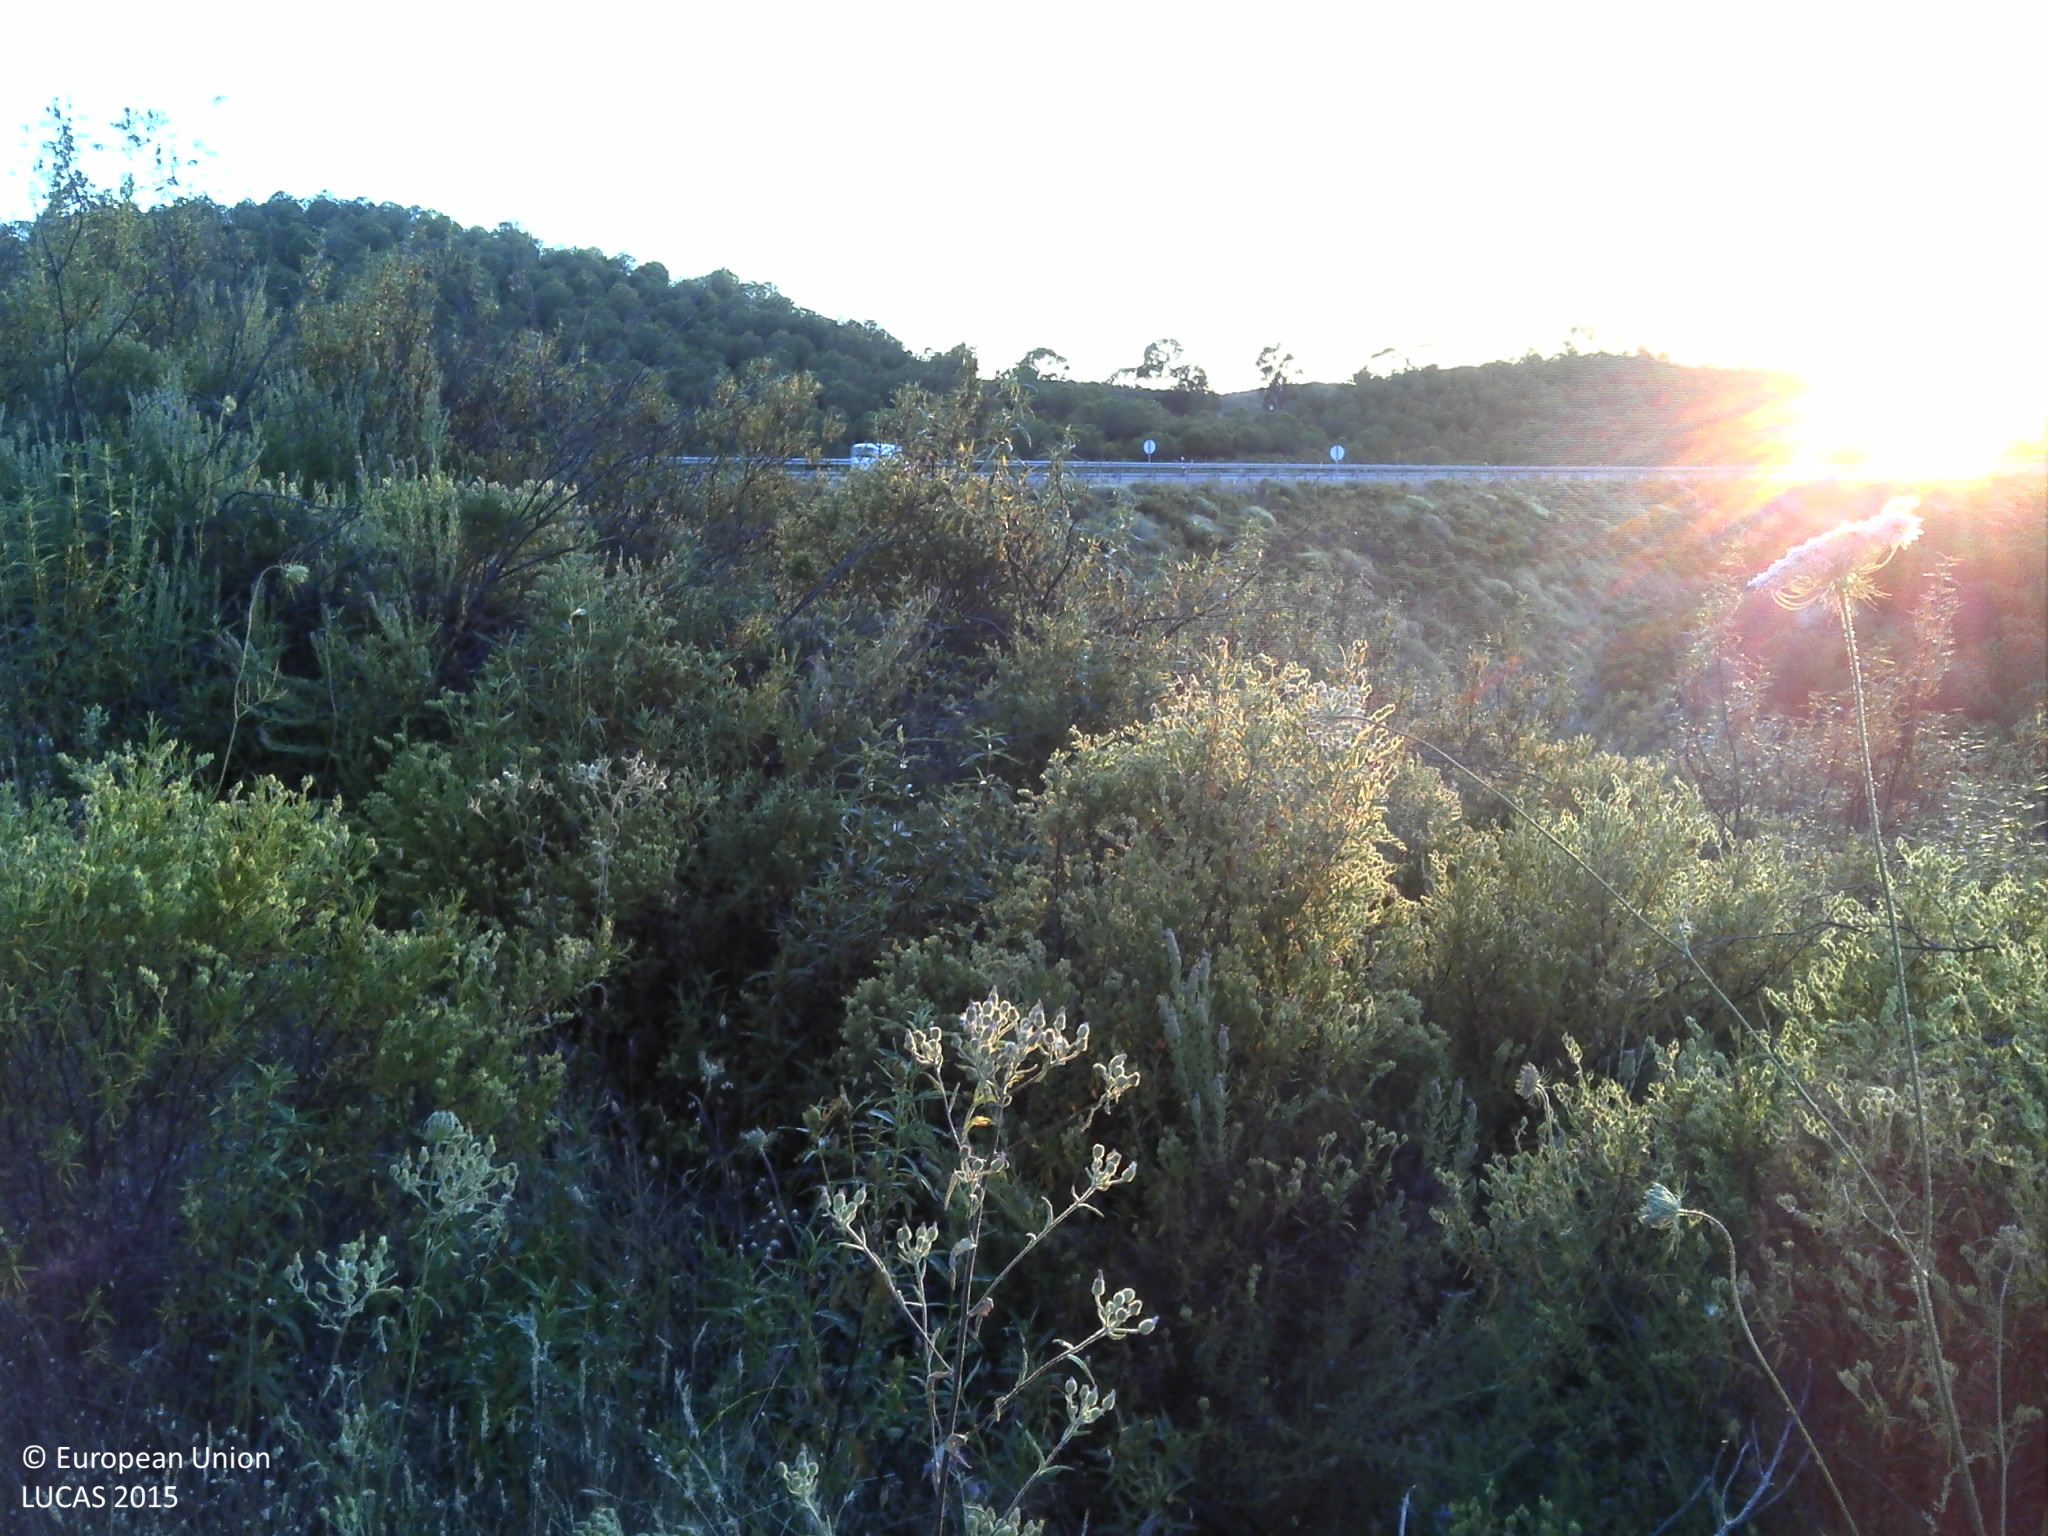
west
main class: Shrubland
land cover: Shrubland without tree cover
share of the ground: > 75 %
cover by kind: shrubs 100 %
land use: Semi-natural and natural areas not in use
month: May
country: PT
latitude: 37.4709
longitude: -7.5470
